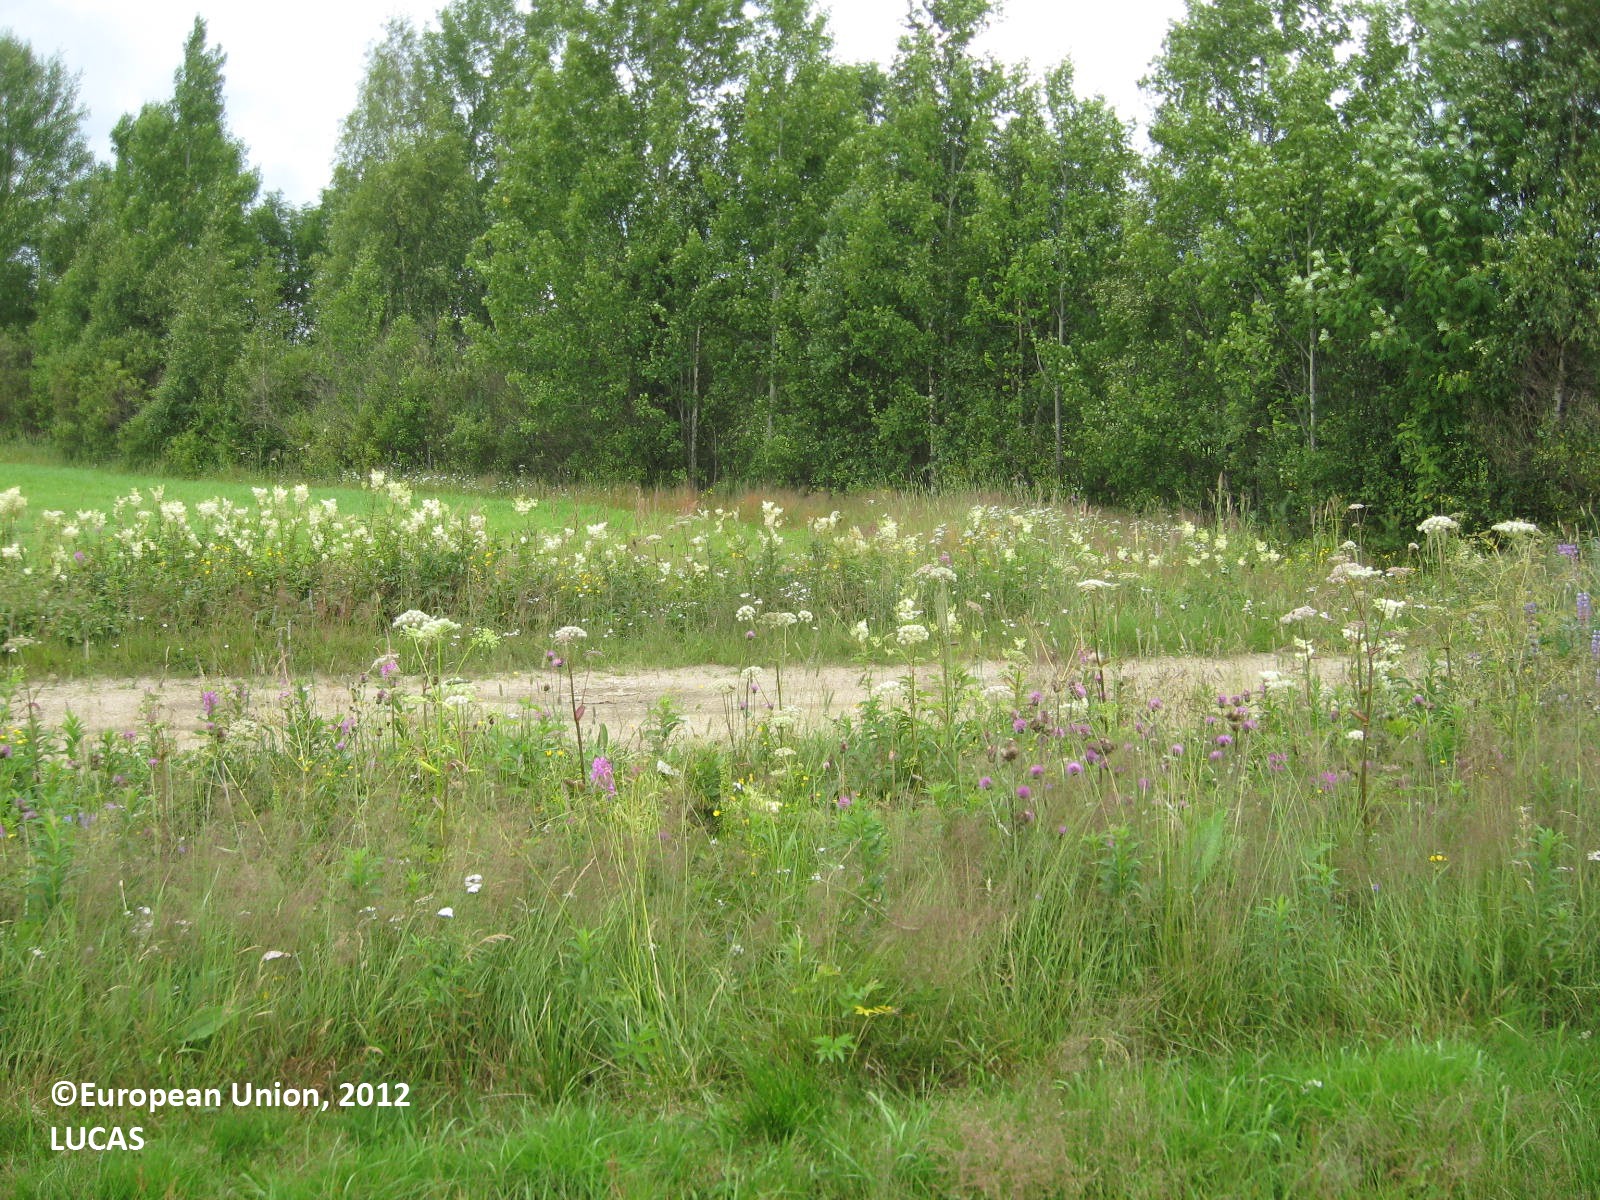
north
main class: Cropland
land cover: Temporary grasslands
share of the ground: > 75 %
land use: Agriculture (excluding fallow land and kitchen gardens)
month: July
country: FI
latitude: 62.1946
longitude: 22.7640
